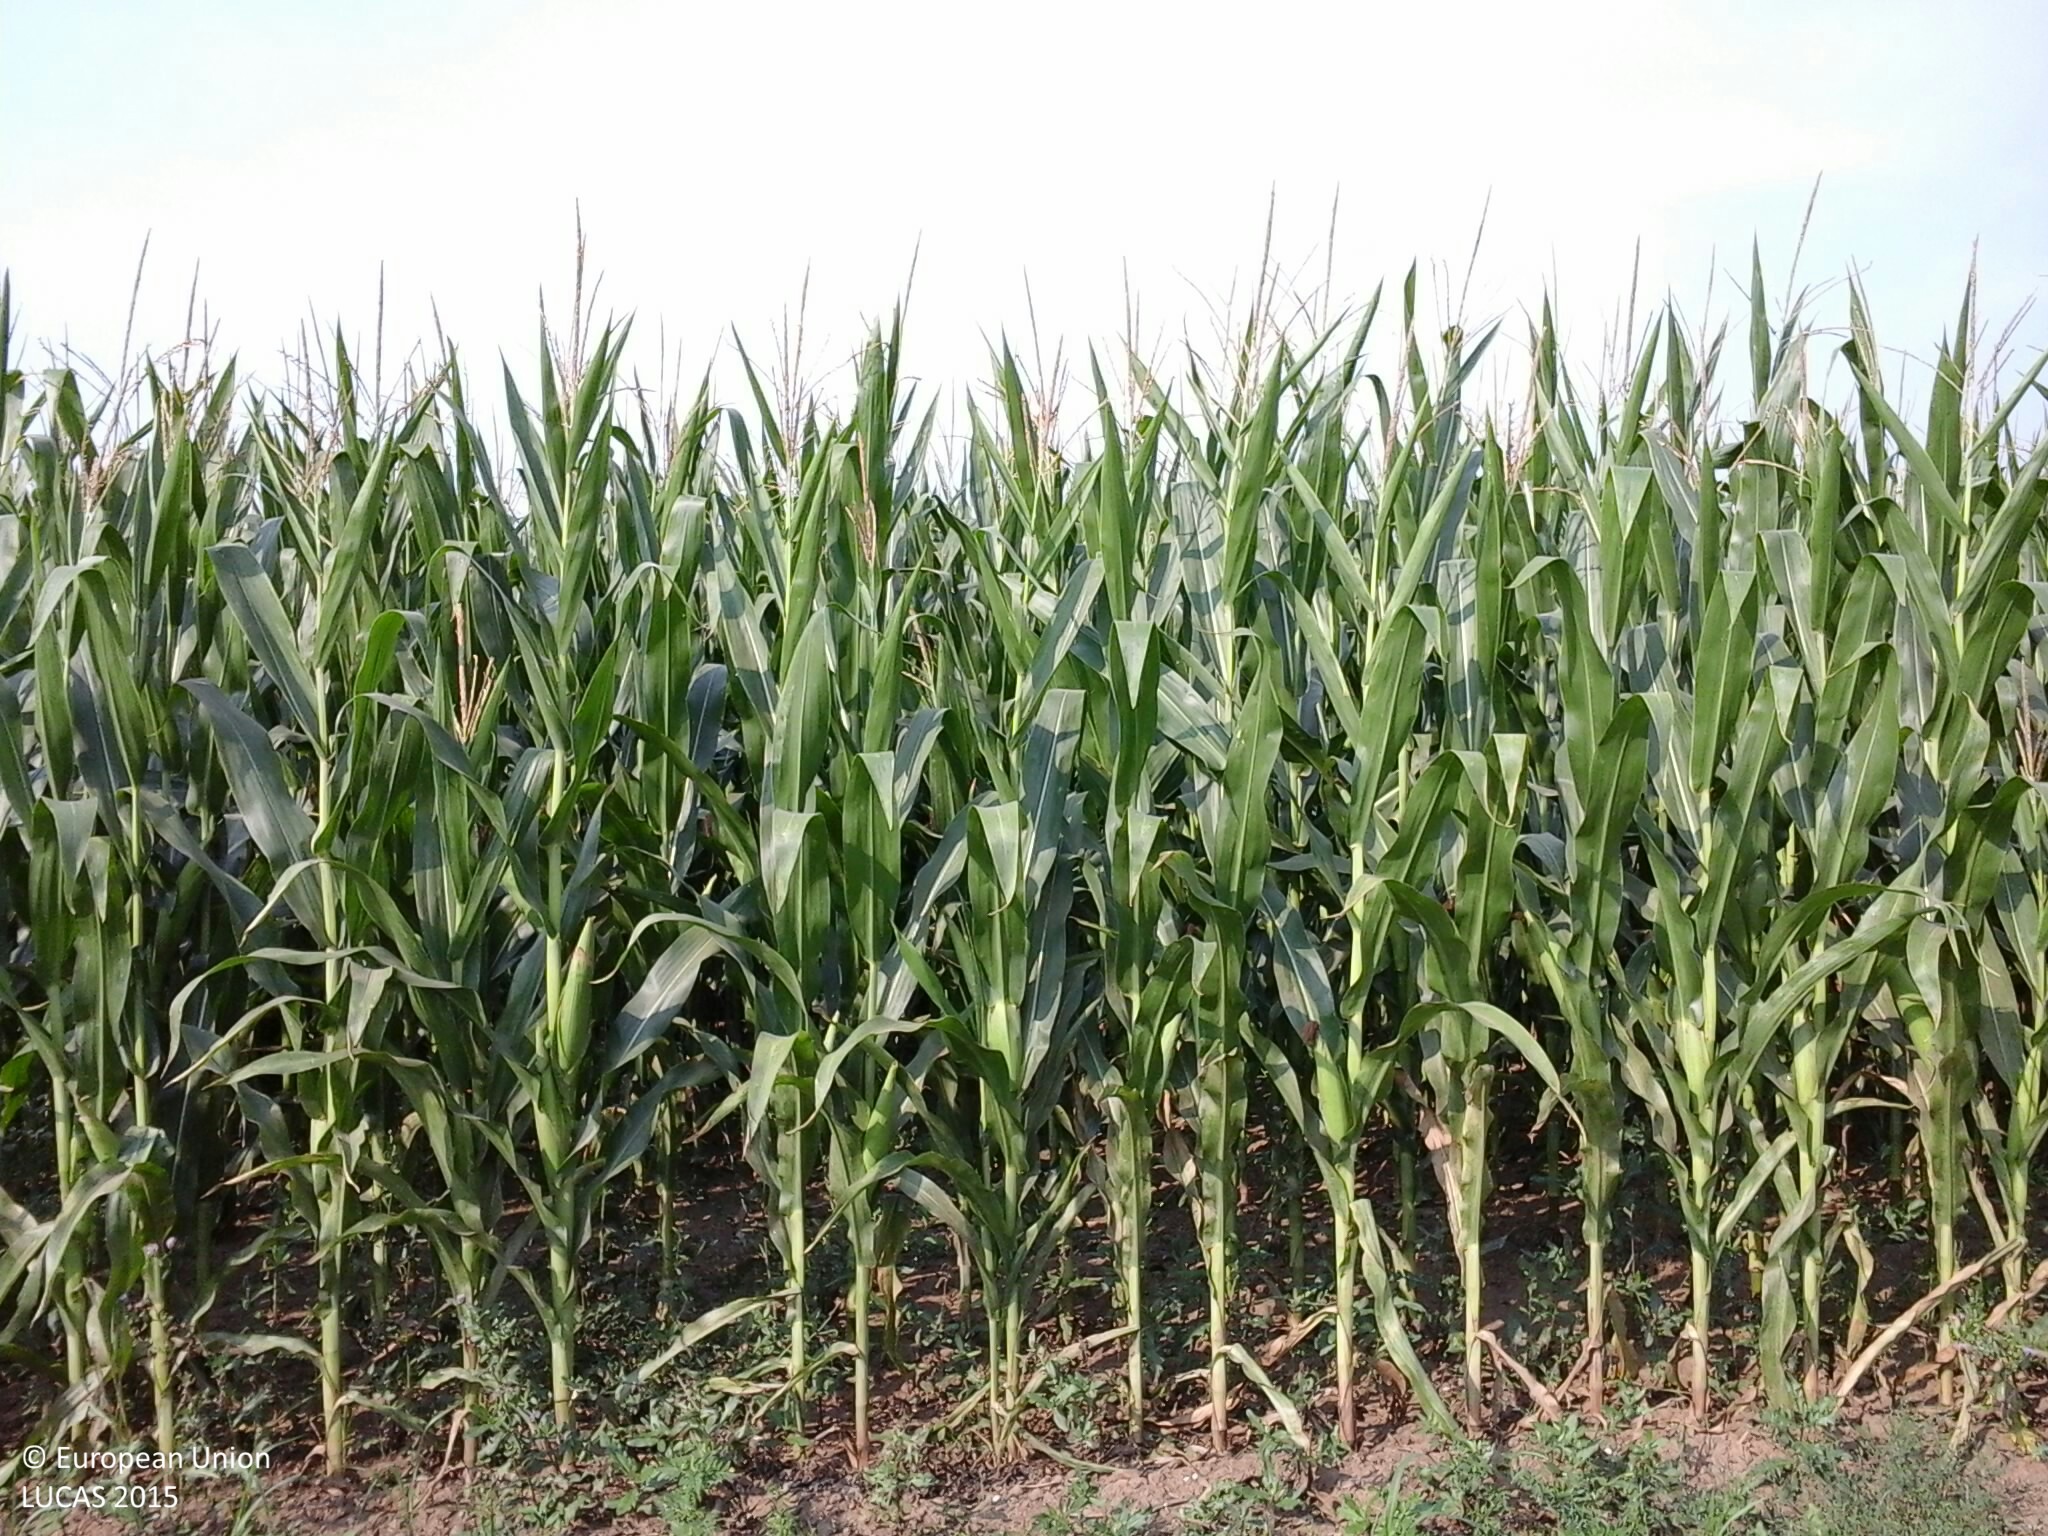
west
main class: Cropland
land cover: Maize
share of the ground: > 75 %
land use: Agriculture (excluding fallow land and kitchen gardens)
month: August
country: HU
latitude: 46.6630
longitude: 18.0459
